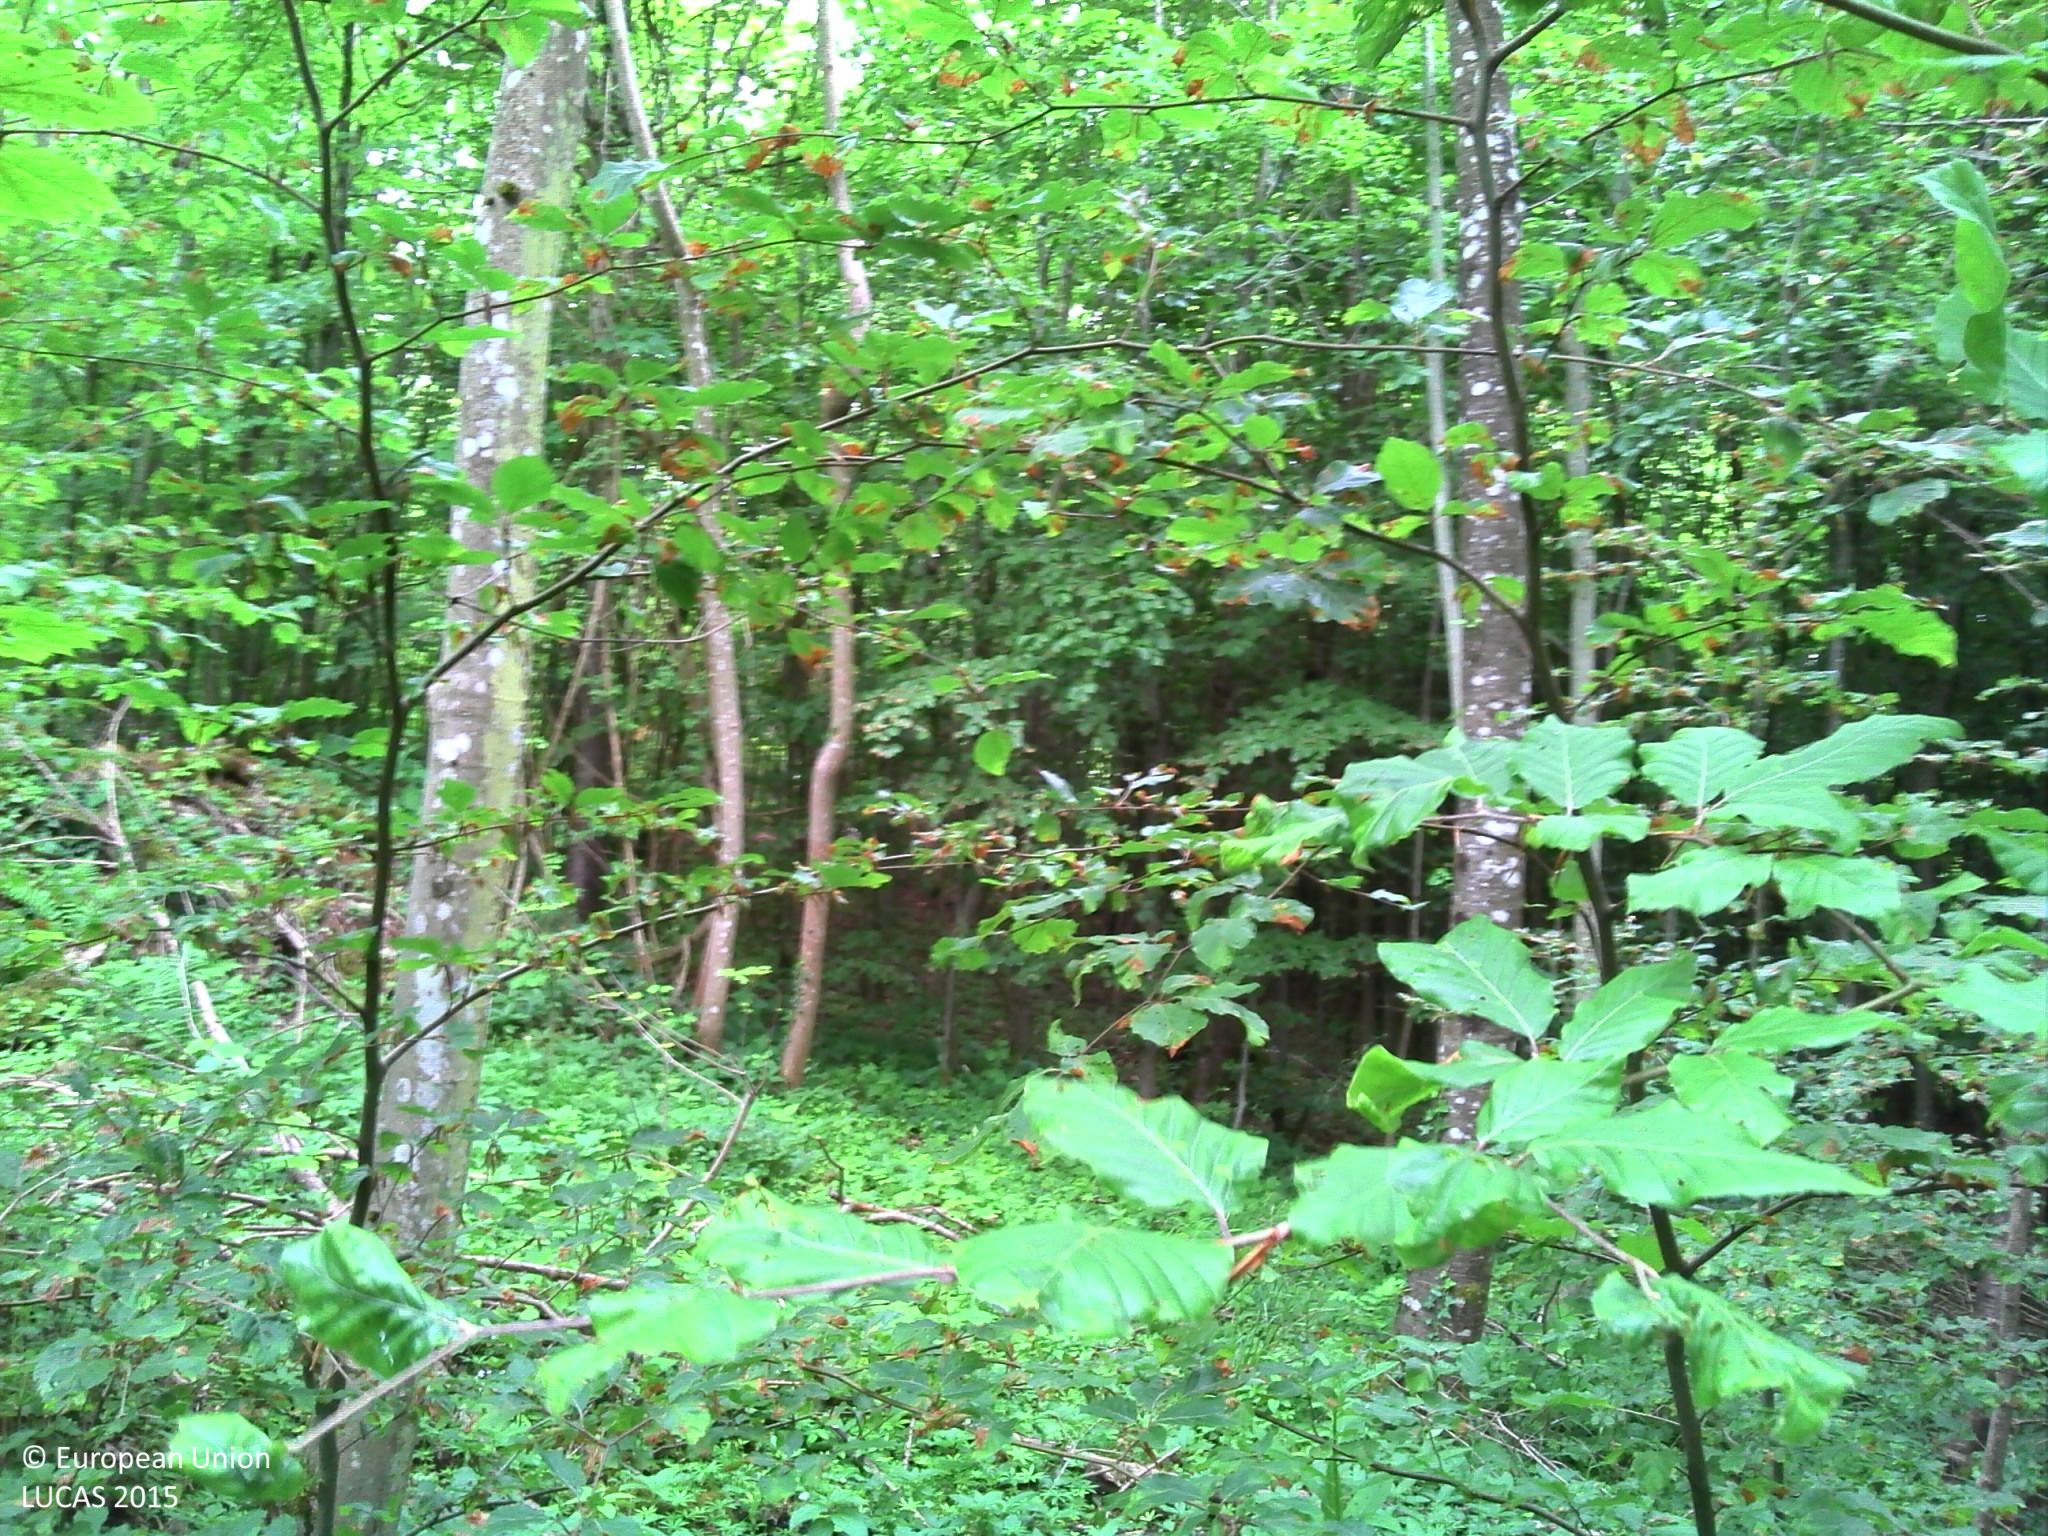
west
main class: Woodland
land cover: Broadleaved woodland
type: beech forest
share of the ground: > 75 %
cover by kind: broadleaved forest trees 75 %, herbaceous plants 20 %, shrubs 5 %
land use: Forestry
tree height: > 5 m
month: June
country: LU
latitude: 49.5331
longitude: 5.8677
